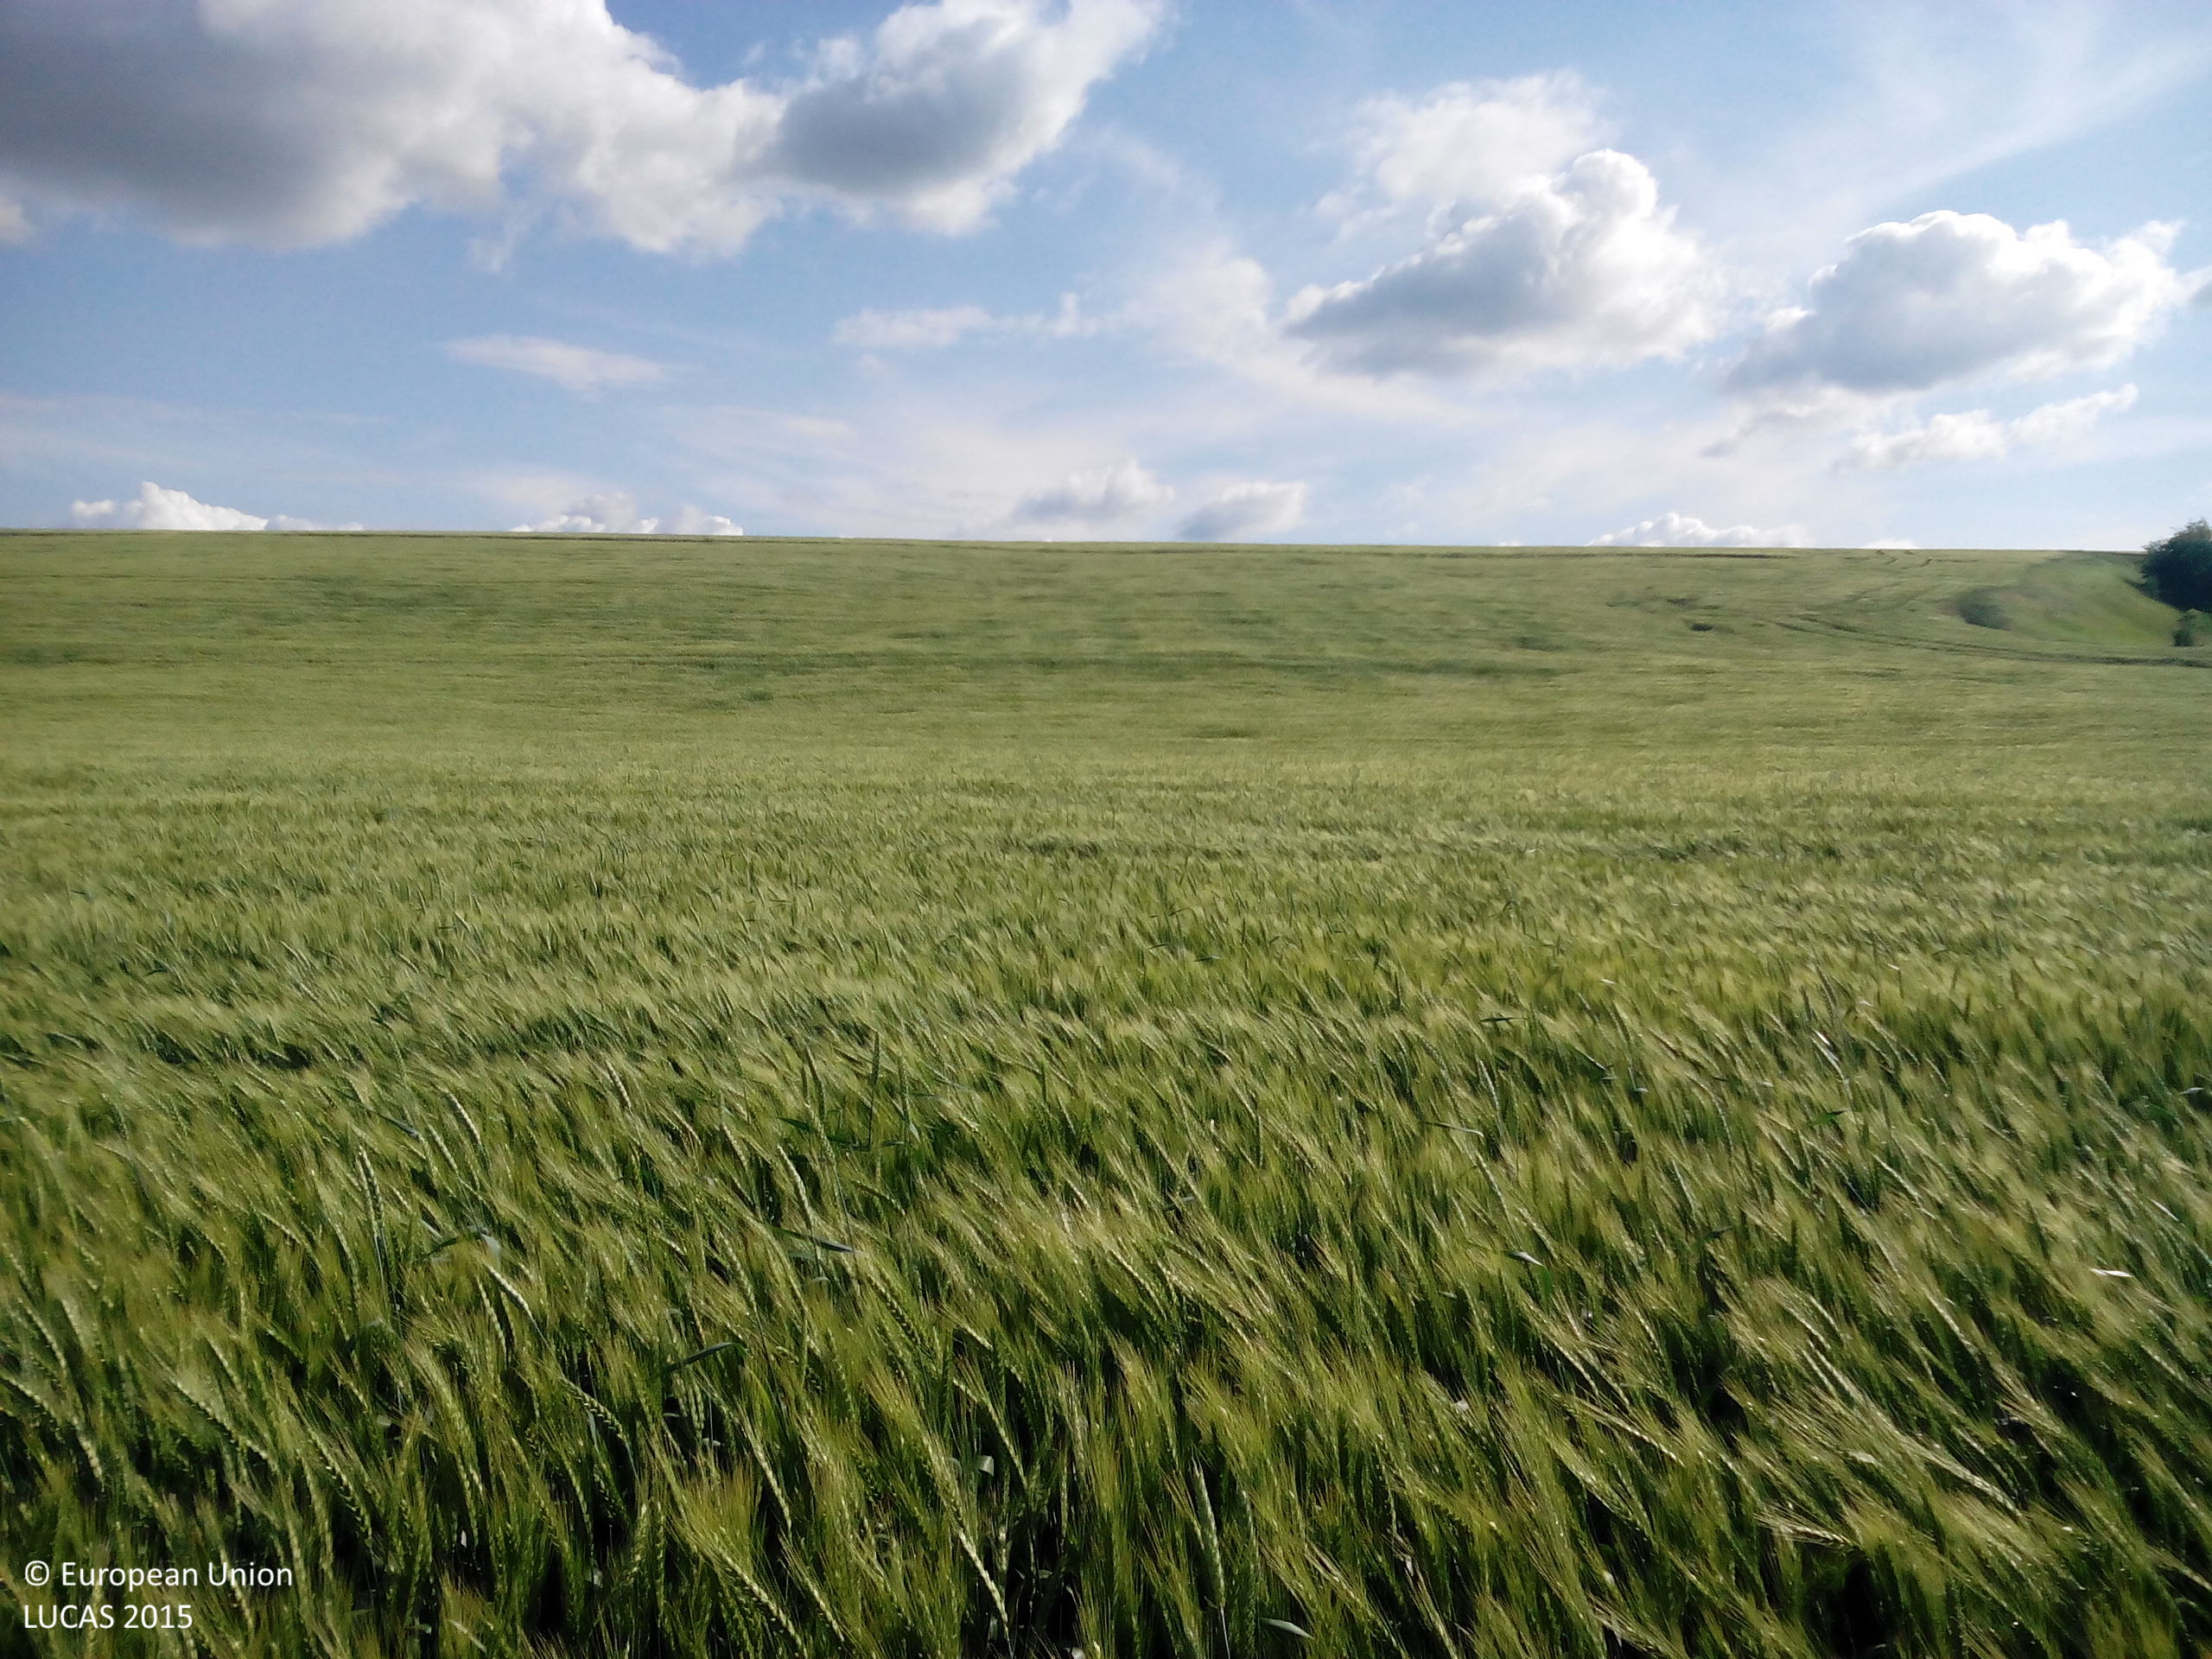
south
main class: Cropland
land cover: Rye
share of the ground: > 75 %
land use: Agriculture (excluding fallow land and kitchen gardens)
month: May
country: BG
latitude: 43.5607
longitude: 24.1316
